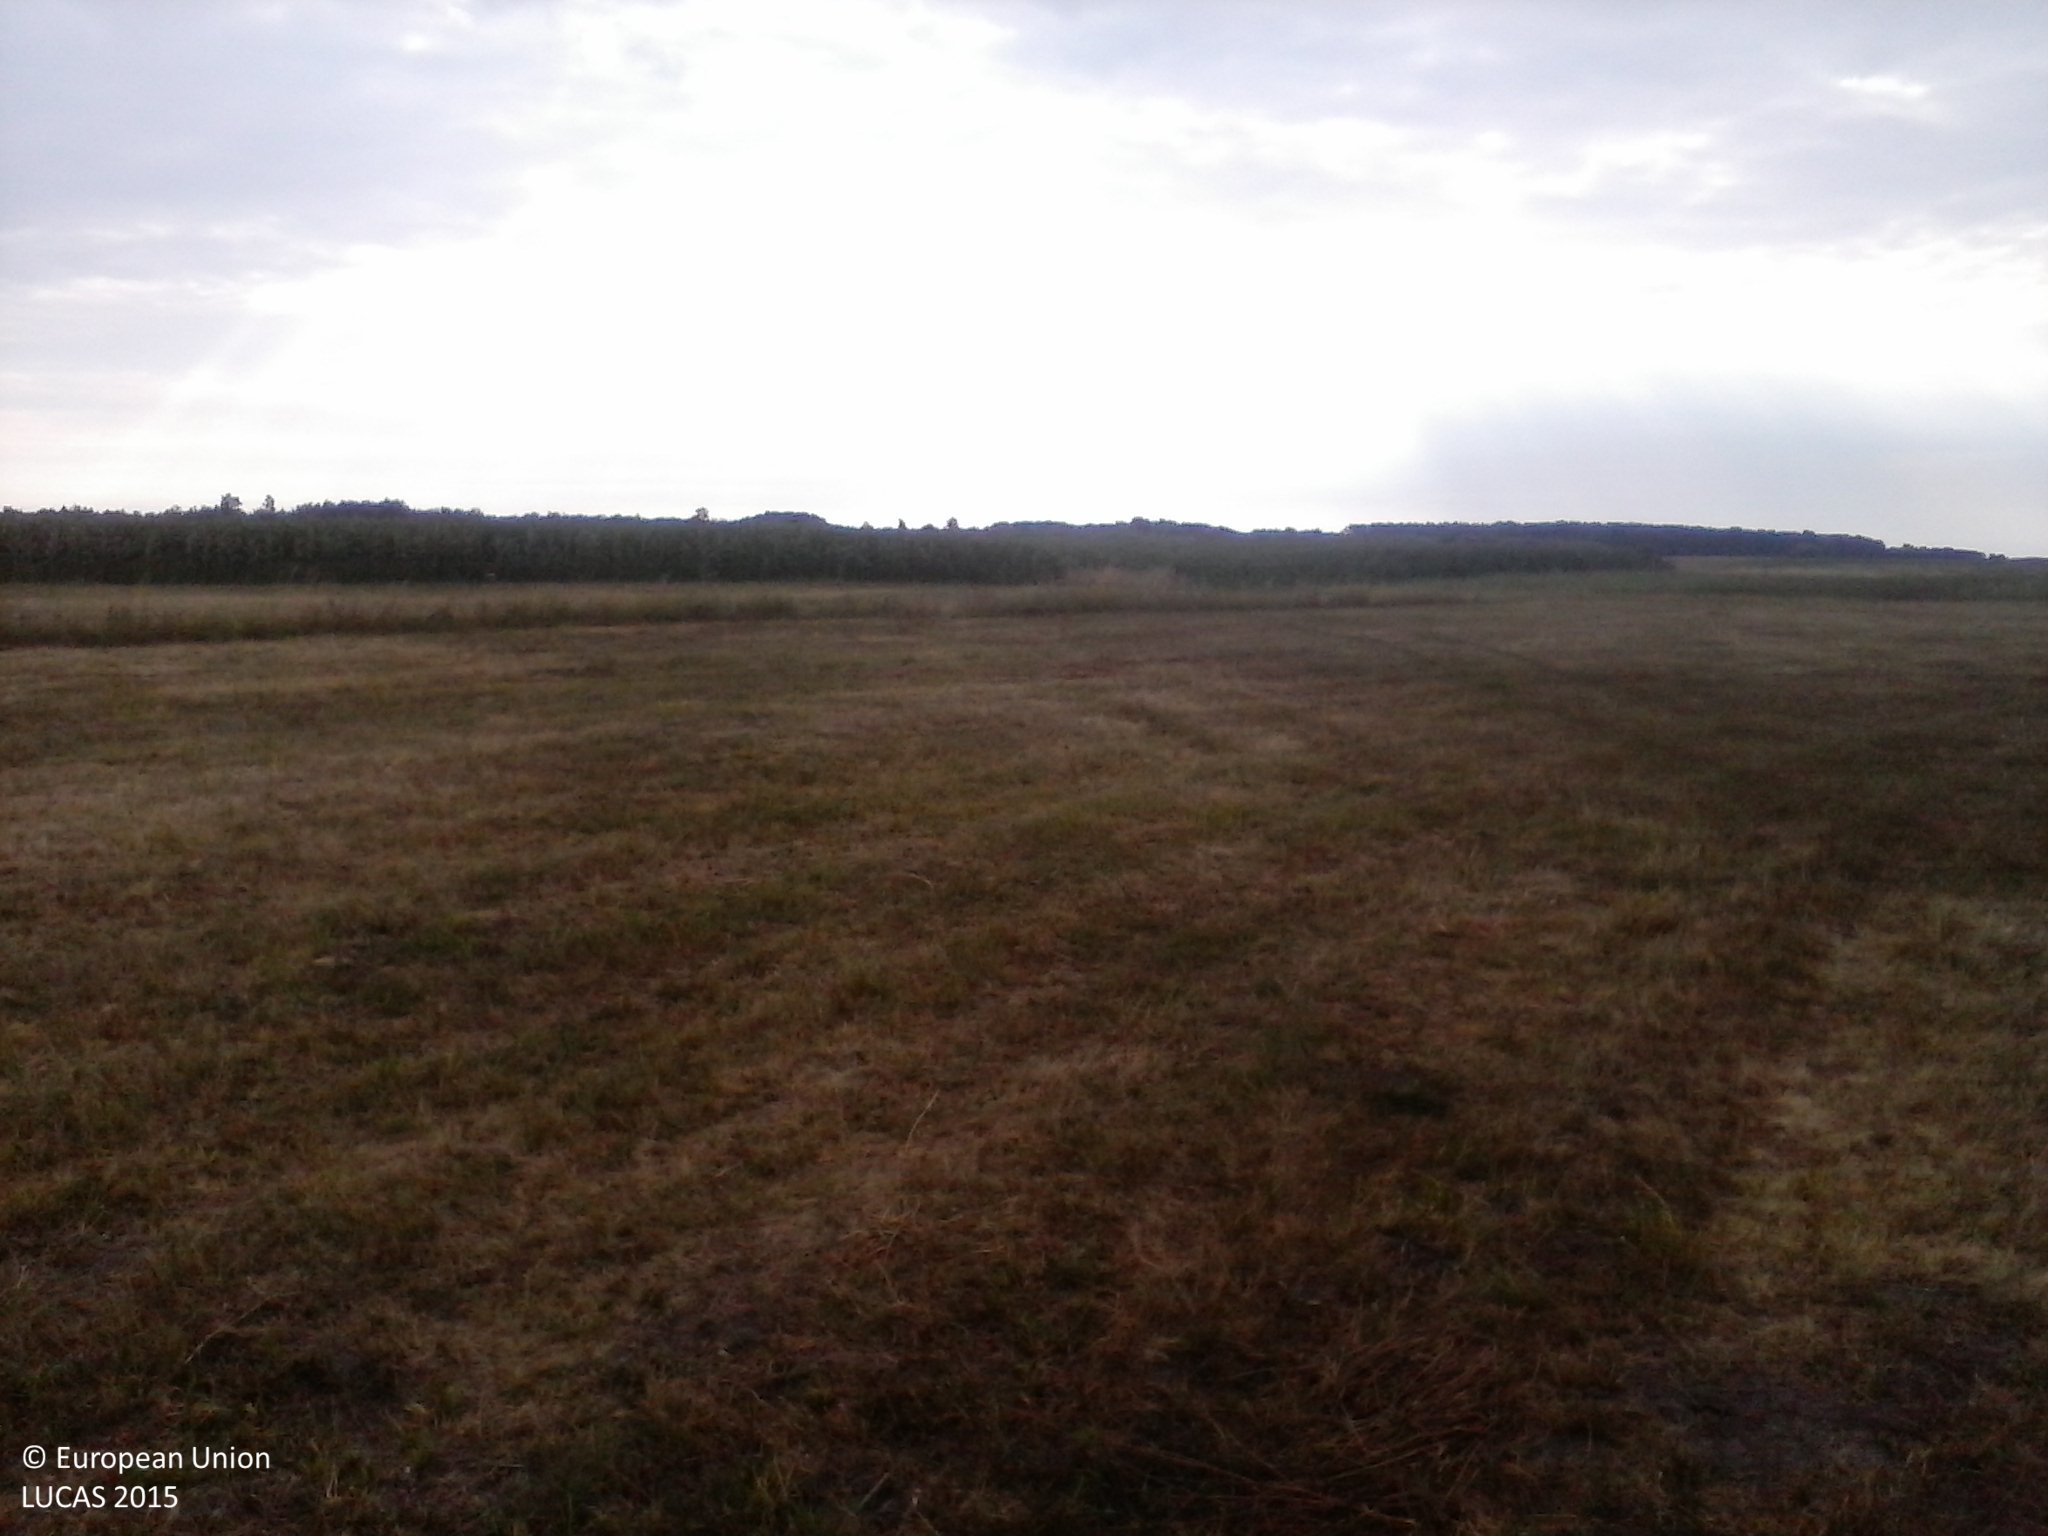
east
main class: Grassland
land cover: Grassland without tree/shrub cover
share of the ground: > 75 %
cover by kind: herbaceous plants 100 %
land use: Agriculture (excluding fallow land and kitchen gardens)
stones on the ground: < 10 %
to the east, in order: Grassland without tree/shrub cover; Maize; Grassland without tree/shrub cover
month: July
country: HU
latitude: 46.4836
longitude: 19.5662
